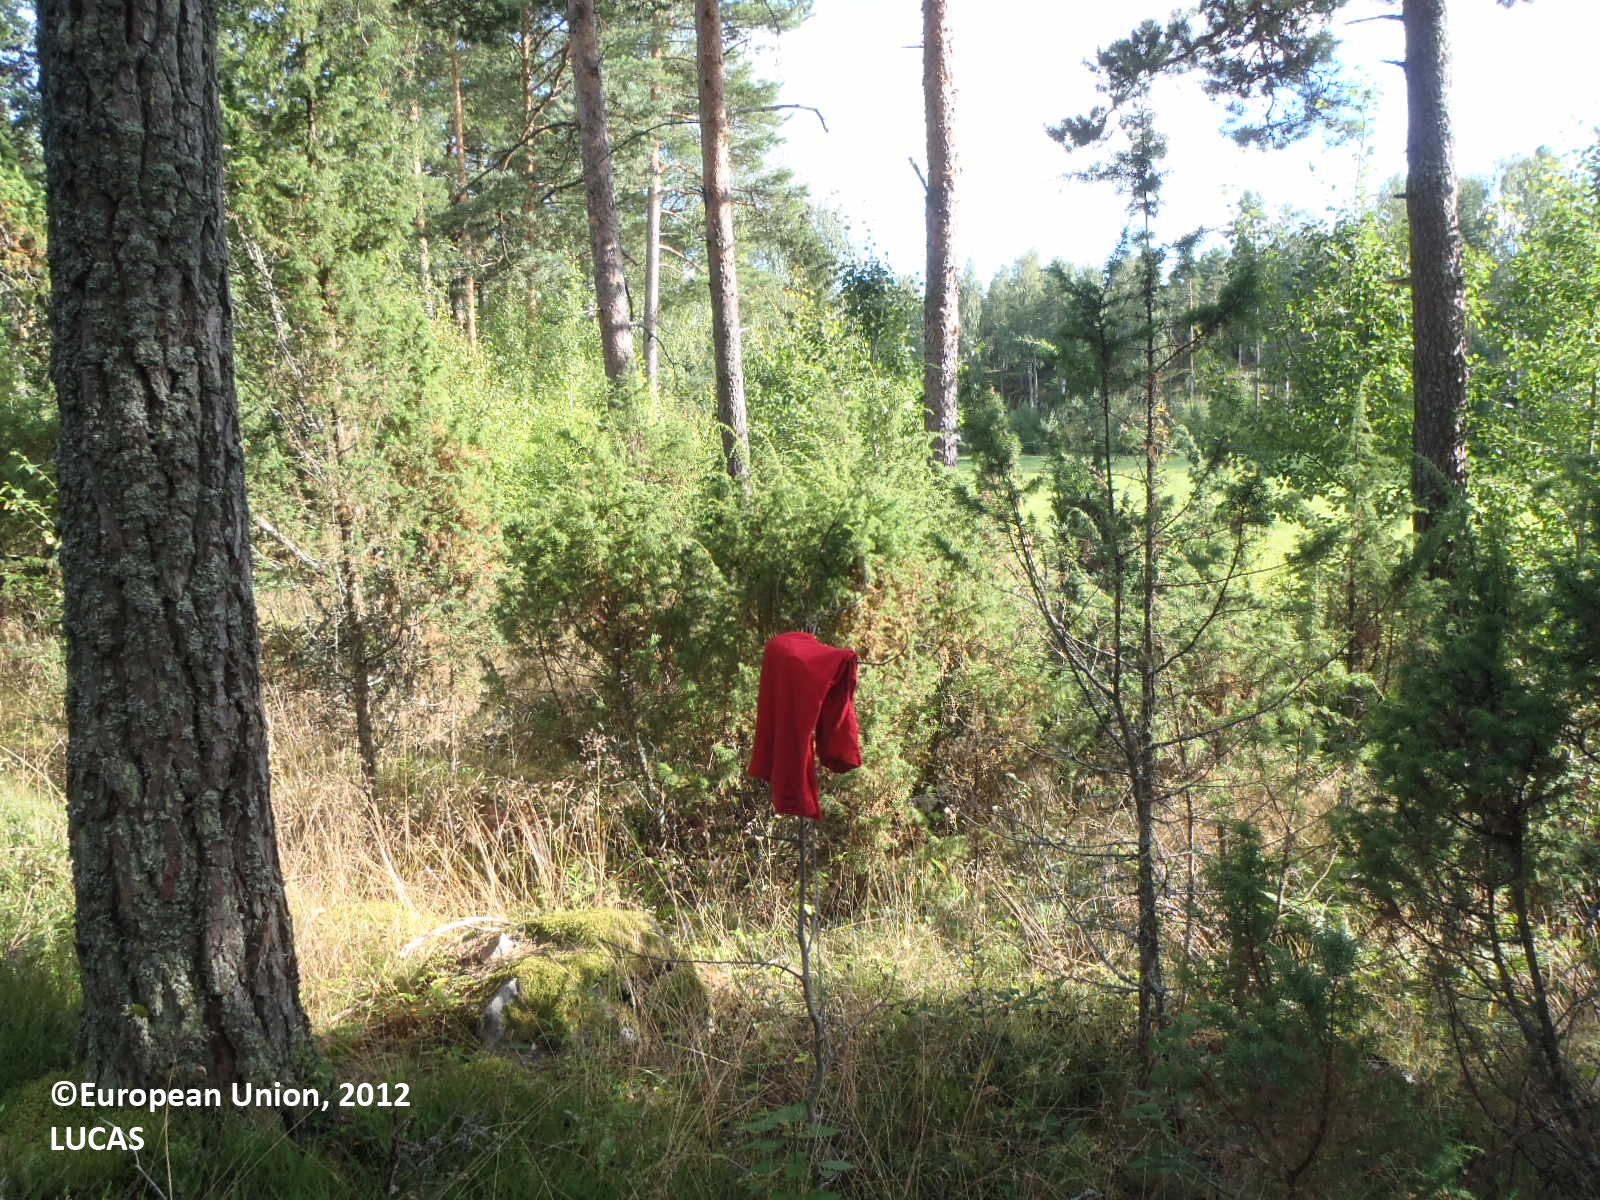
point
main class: Woodland
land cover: Pine dominated coniferous woodland
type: boreal forest
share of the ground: > 75 %
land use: Forestry
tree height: > 5 m
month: August
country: FI
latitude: 60.3308
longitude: 22.3301
